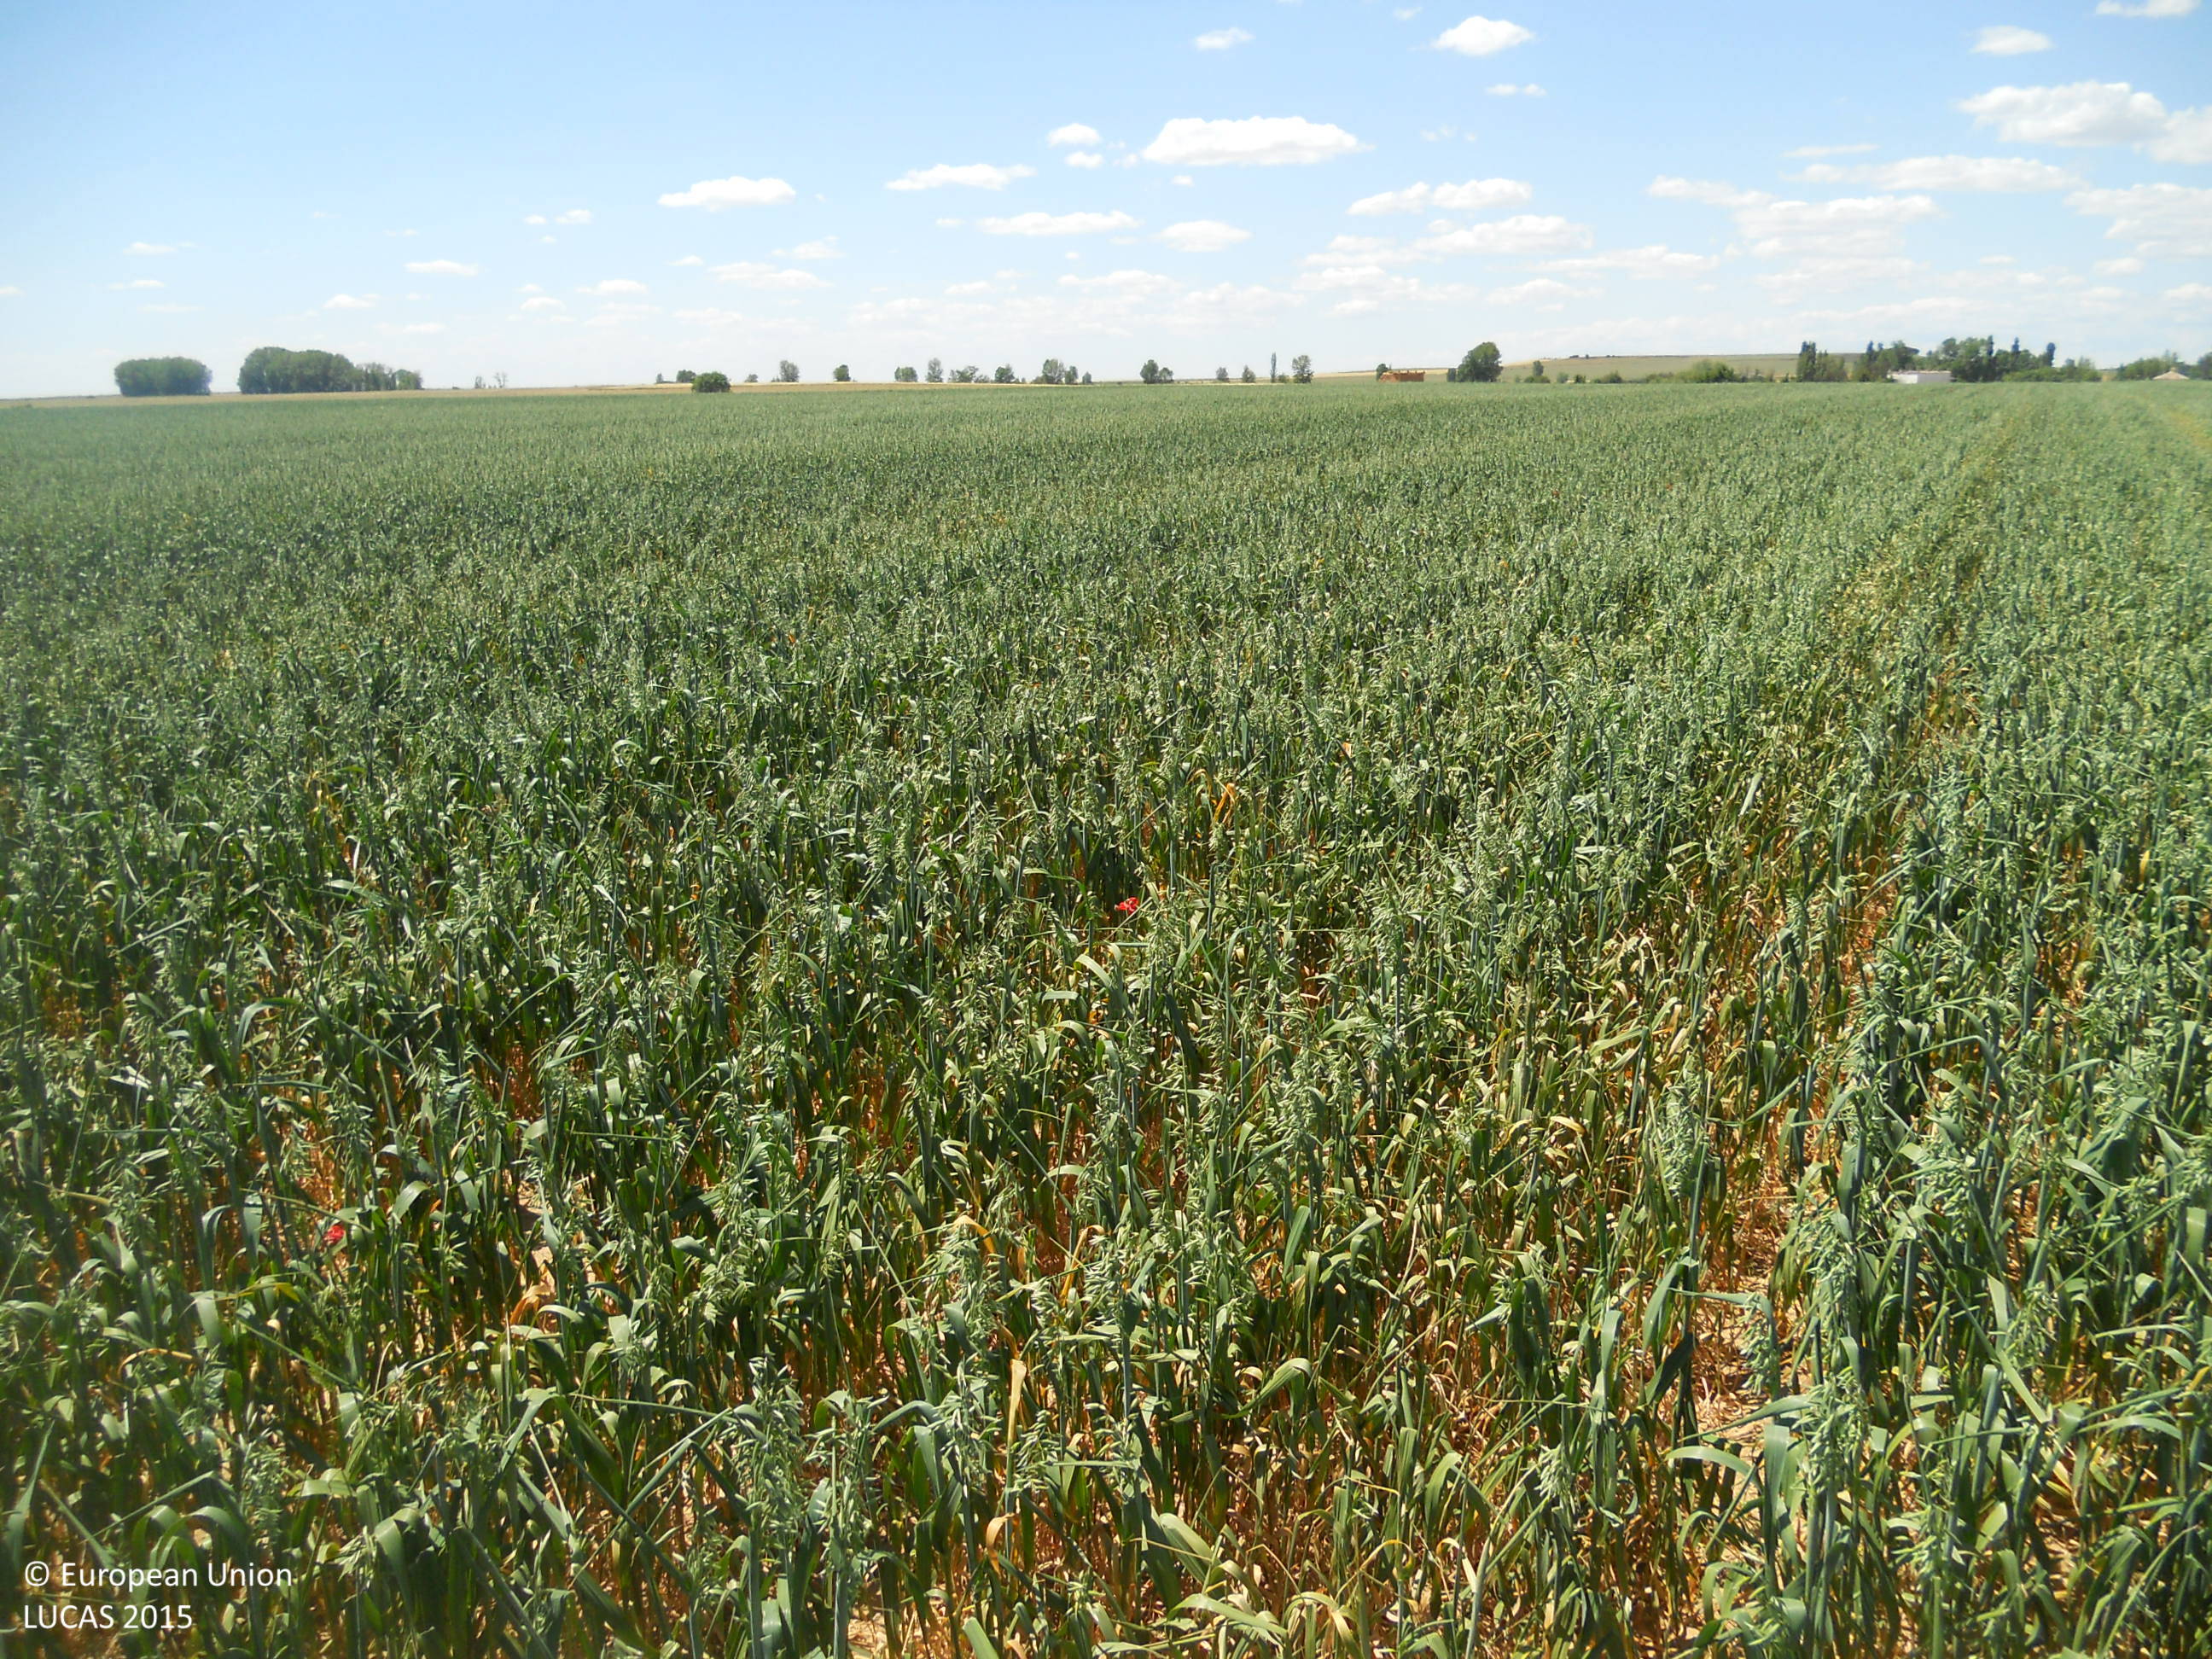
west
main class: Cropland
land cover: Oats
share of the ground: > 75 %
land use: Agriculture (excluding fallow land and kitchen gardens)
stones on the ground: < 10 %
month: May
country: ES
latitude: 42.2944
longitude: -4.7905
